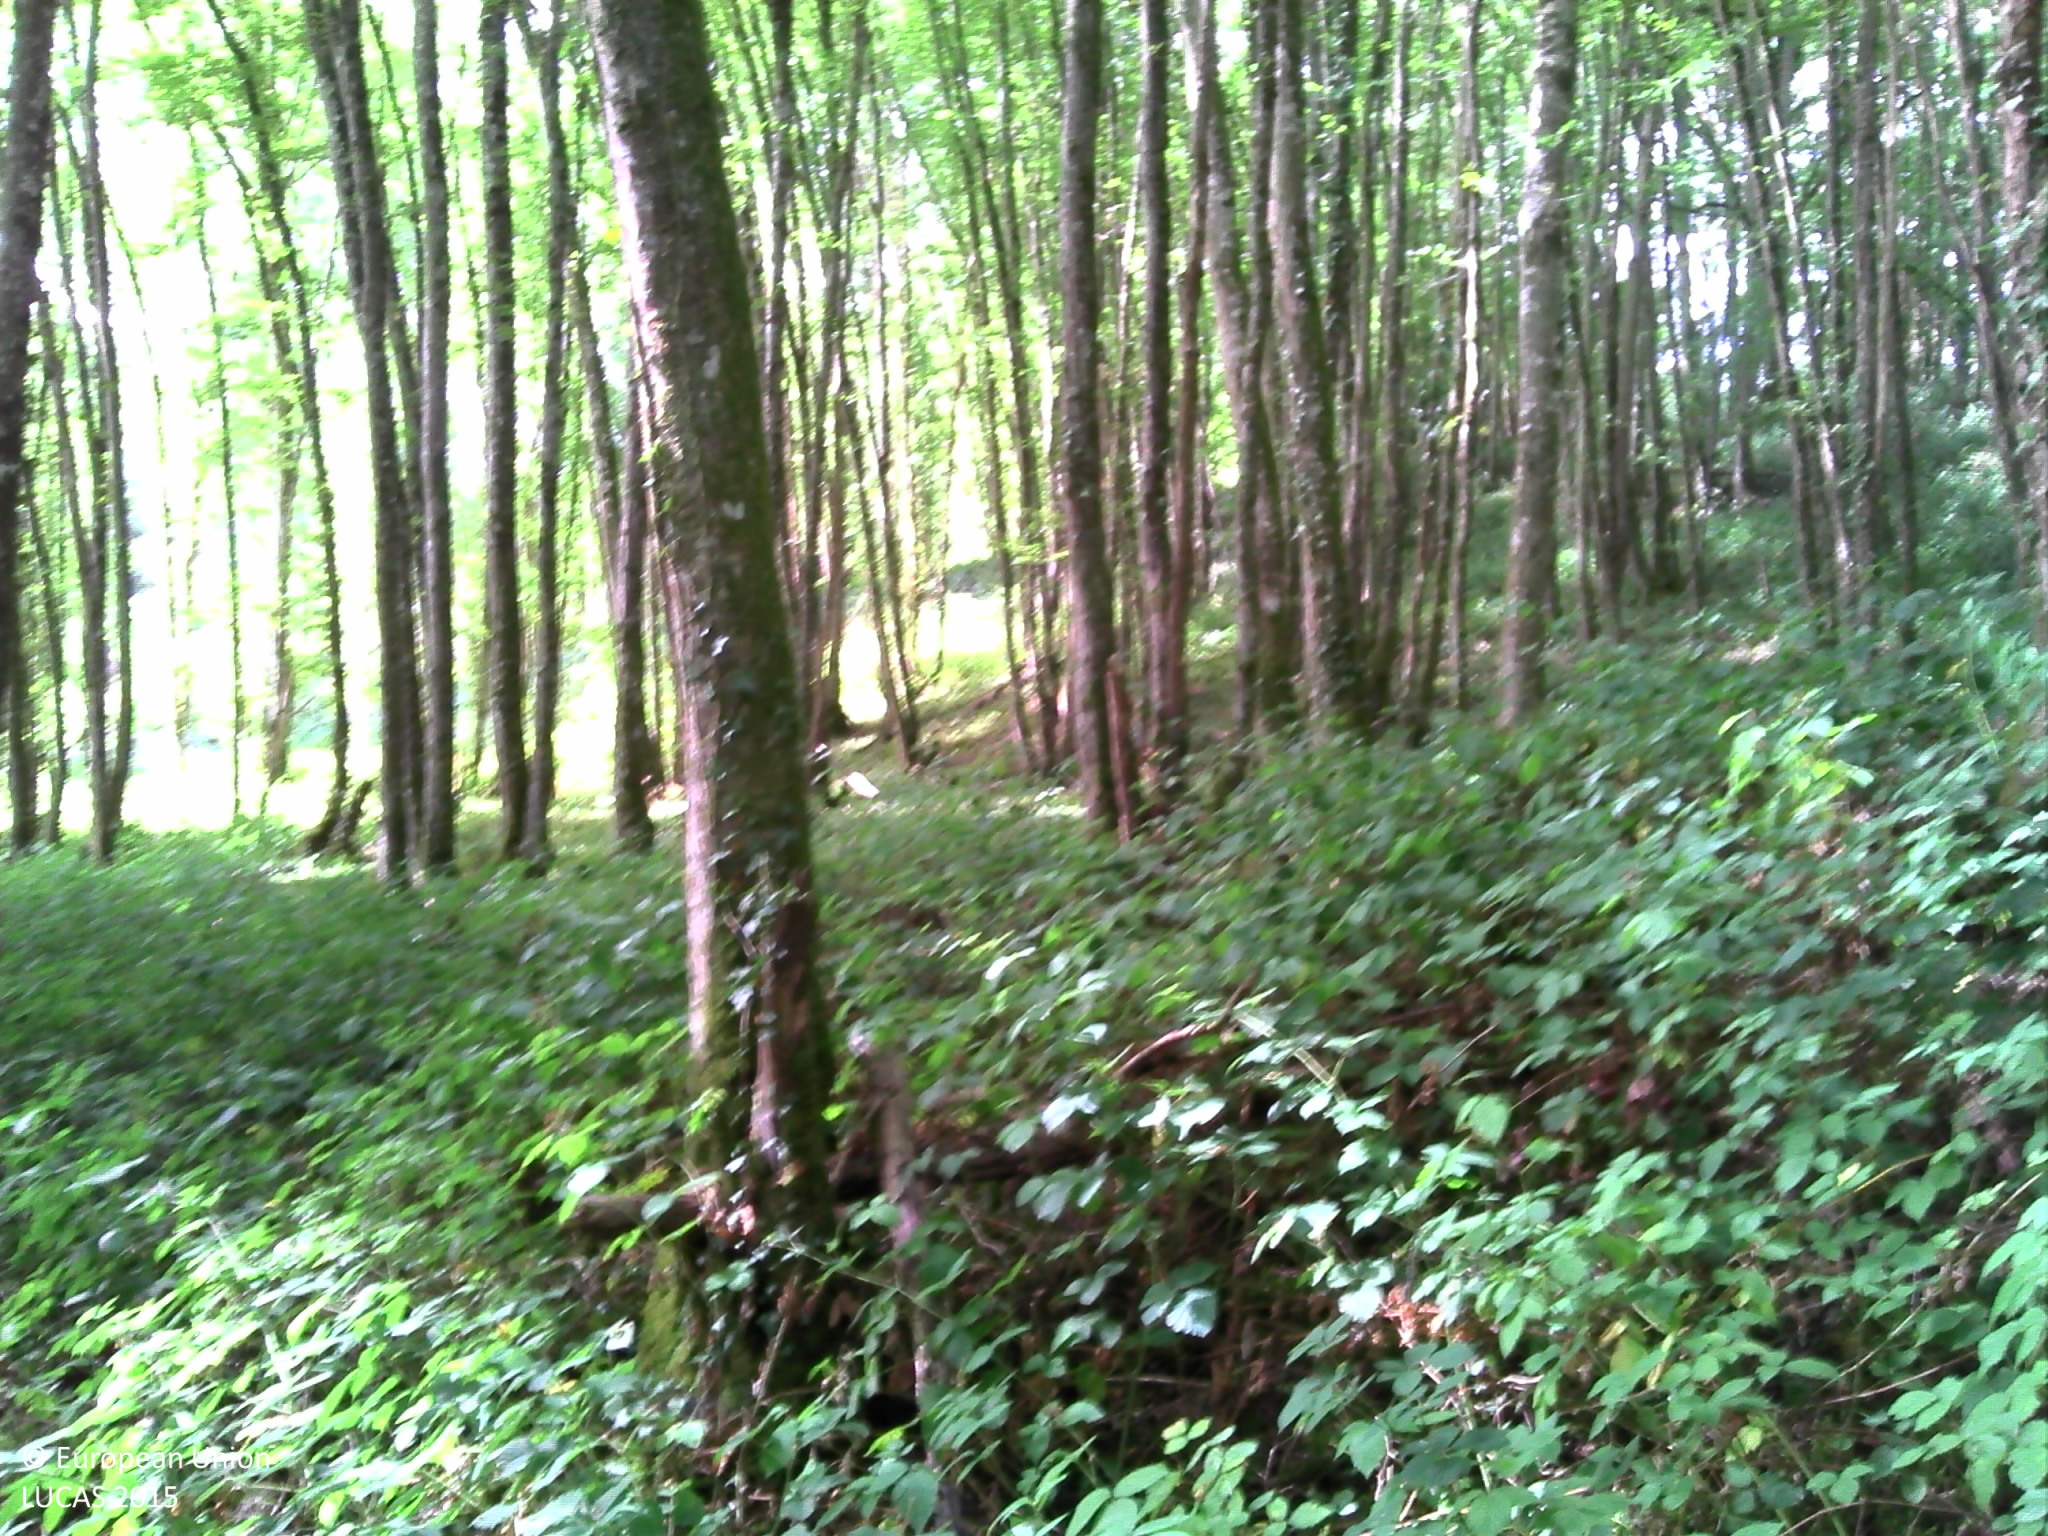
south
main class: Woodland
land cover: Broadleaved woodland
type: mesophytic deciduous forest
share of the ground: > 75 %
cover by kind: broadleaved forest trees 90 %, herbaceous plants 5 %, lichens and mosses 5 %
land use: Forestry
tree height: > 5 m
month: July
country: FR
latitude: 47.9154
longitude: 3.0756
